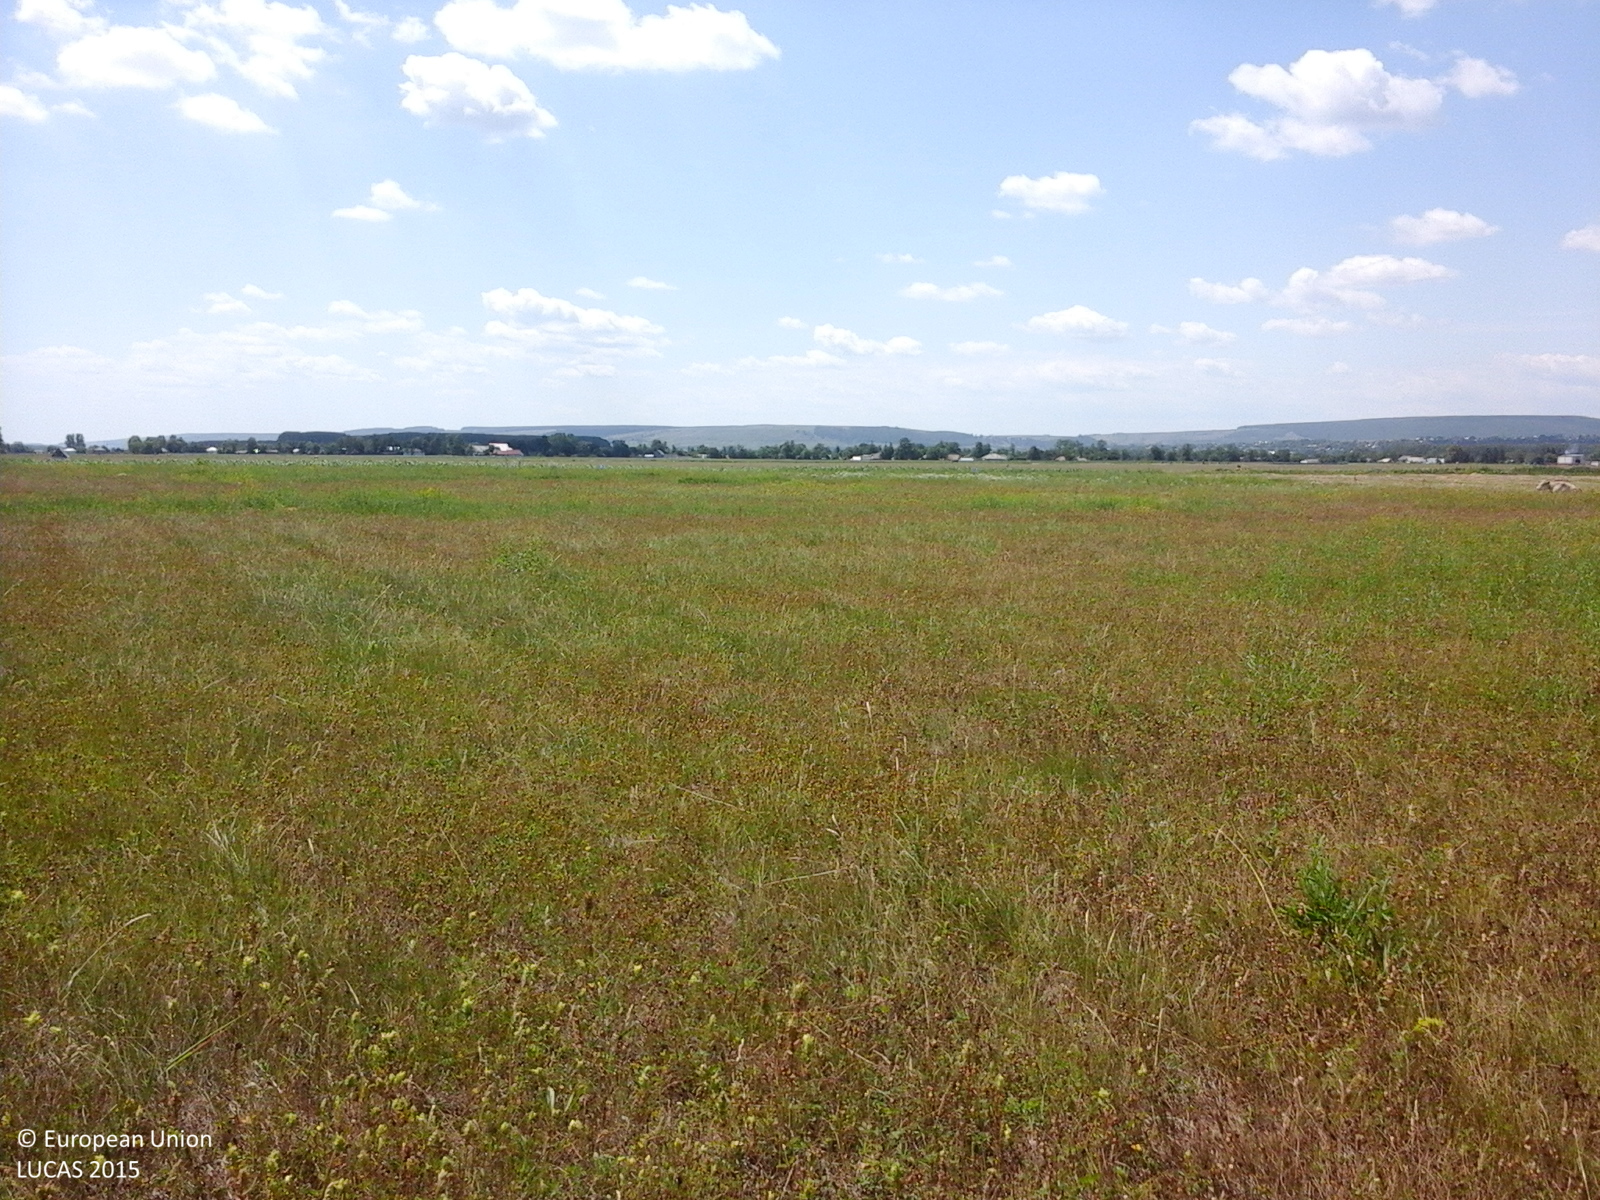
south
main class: Grassland
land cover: Grassland without tree/shrub cover
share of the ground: > 75 %
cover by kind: herbaceous plants 100 %
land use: Agriculture (excluding fallow land and kitchen gardens)
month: June
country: RO
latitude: 47.5482
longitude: 26.5537
